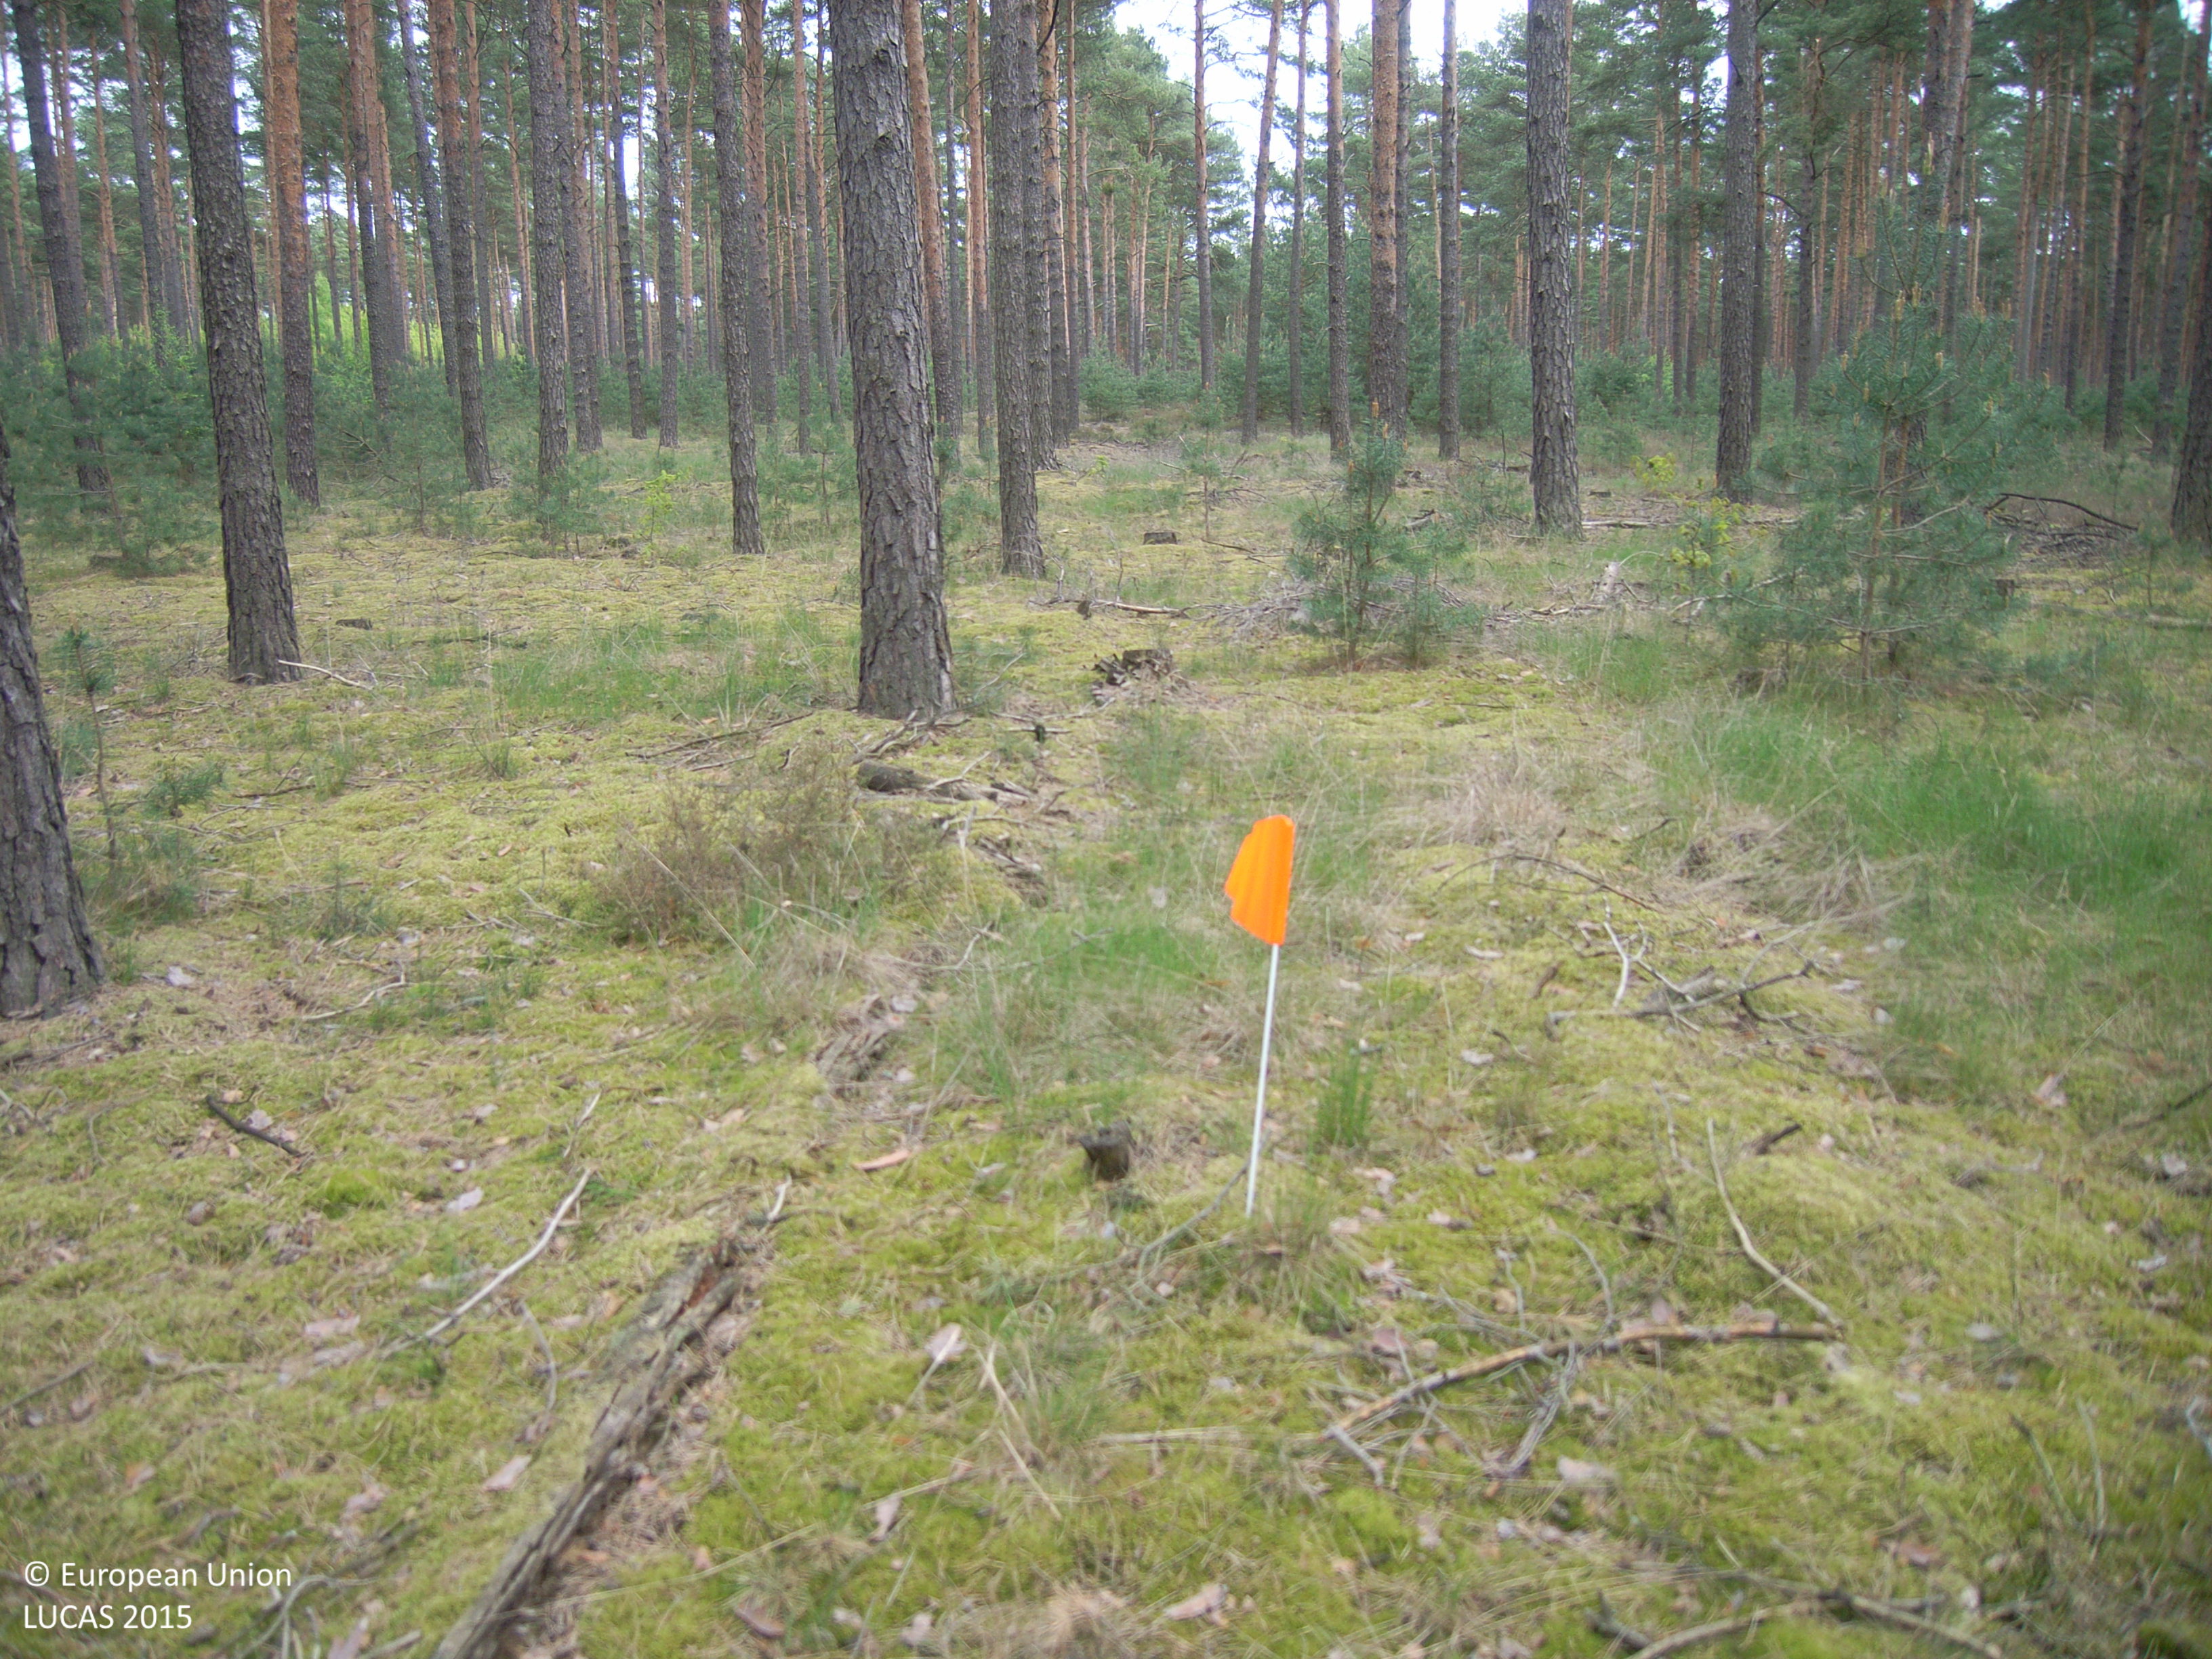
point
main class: Woodland
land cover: Pine dominated coniferous woodland
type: hemiboreal forest and nemoral coniferous forest and mixed broadleaved-coniferous forest
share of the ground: > 75 %
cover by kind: coniferous forest trees 100 %
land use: Forestry
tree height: > 5 m
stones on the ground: < 10 %
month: May
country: DE
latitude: 52.0898
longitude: 13.5762
